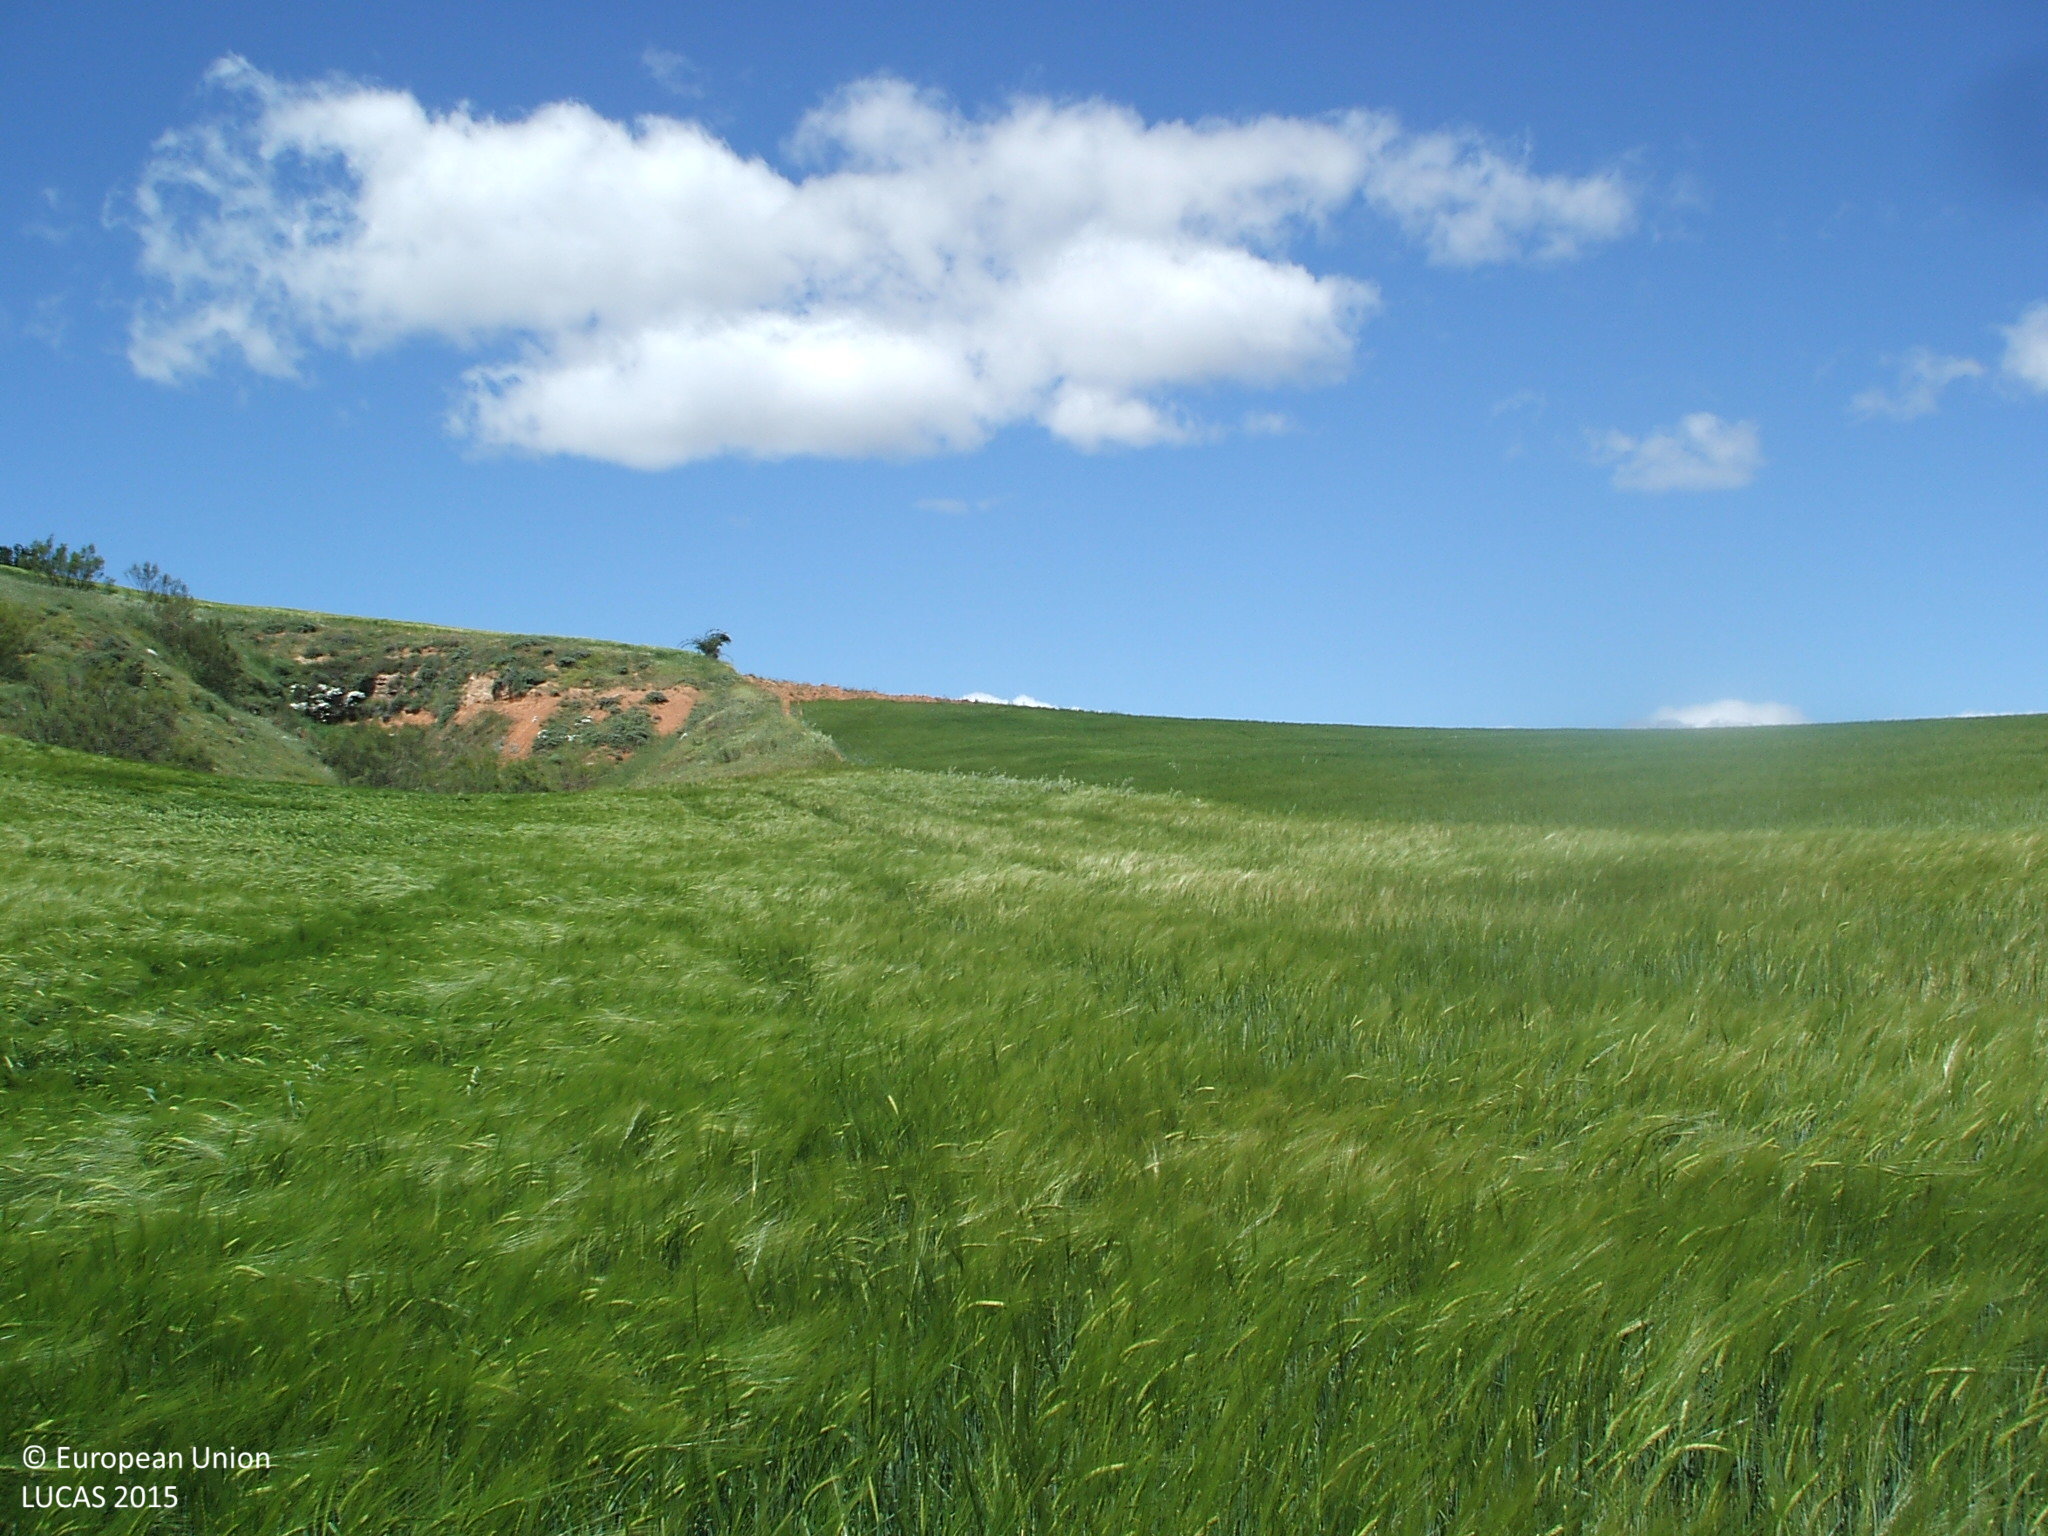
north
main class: Cropland
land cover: Barley
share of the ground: > 75 %
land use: Agriculture (excluding fallow land and kitchen gardens)
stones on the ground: > 50 %
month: May
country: ES
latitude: 40.9537
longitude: -2.9965
